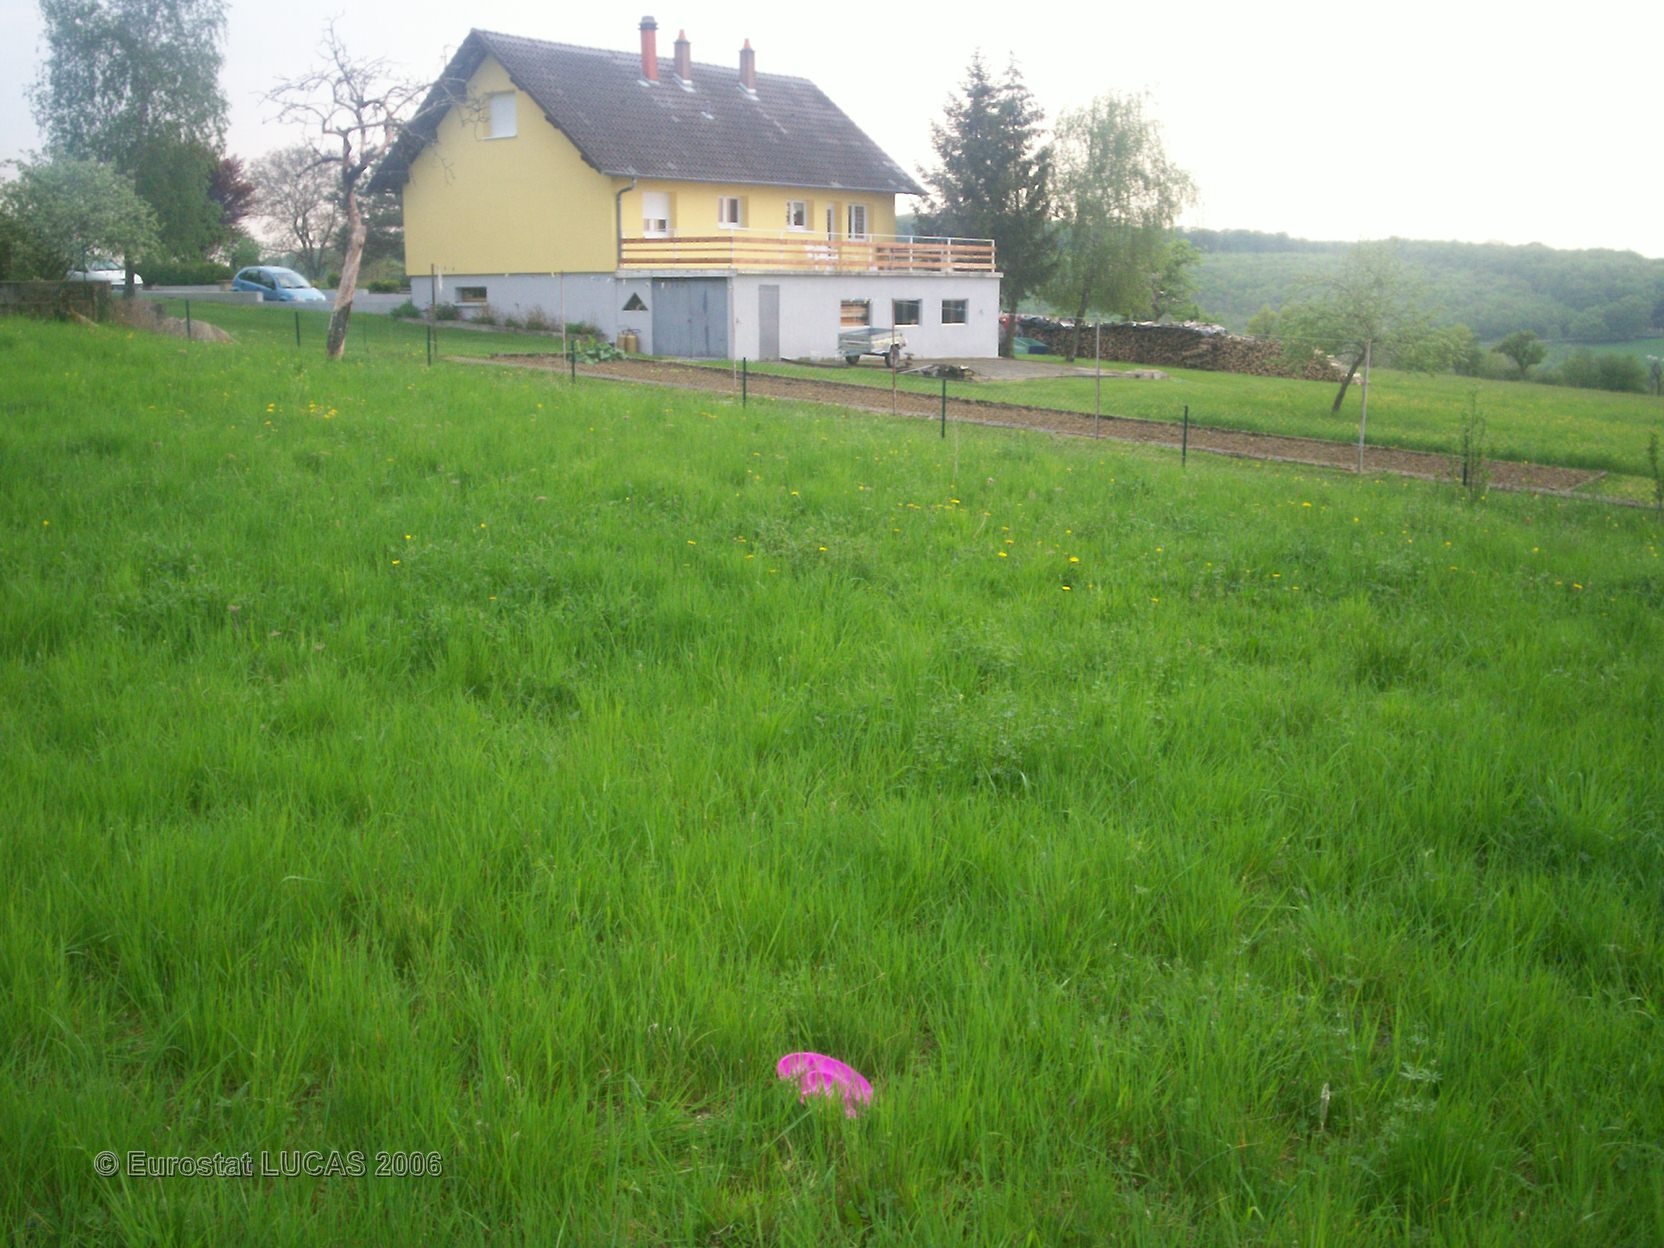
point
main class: Grassland
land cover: Grassland with sparse tree/shrub cover
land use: Agriculture (excluding fallow land and kitchen gardens)
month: May
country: FR
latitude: 48.7775
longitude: 7.0204
